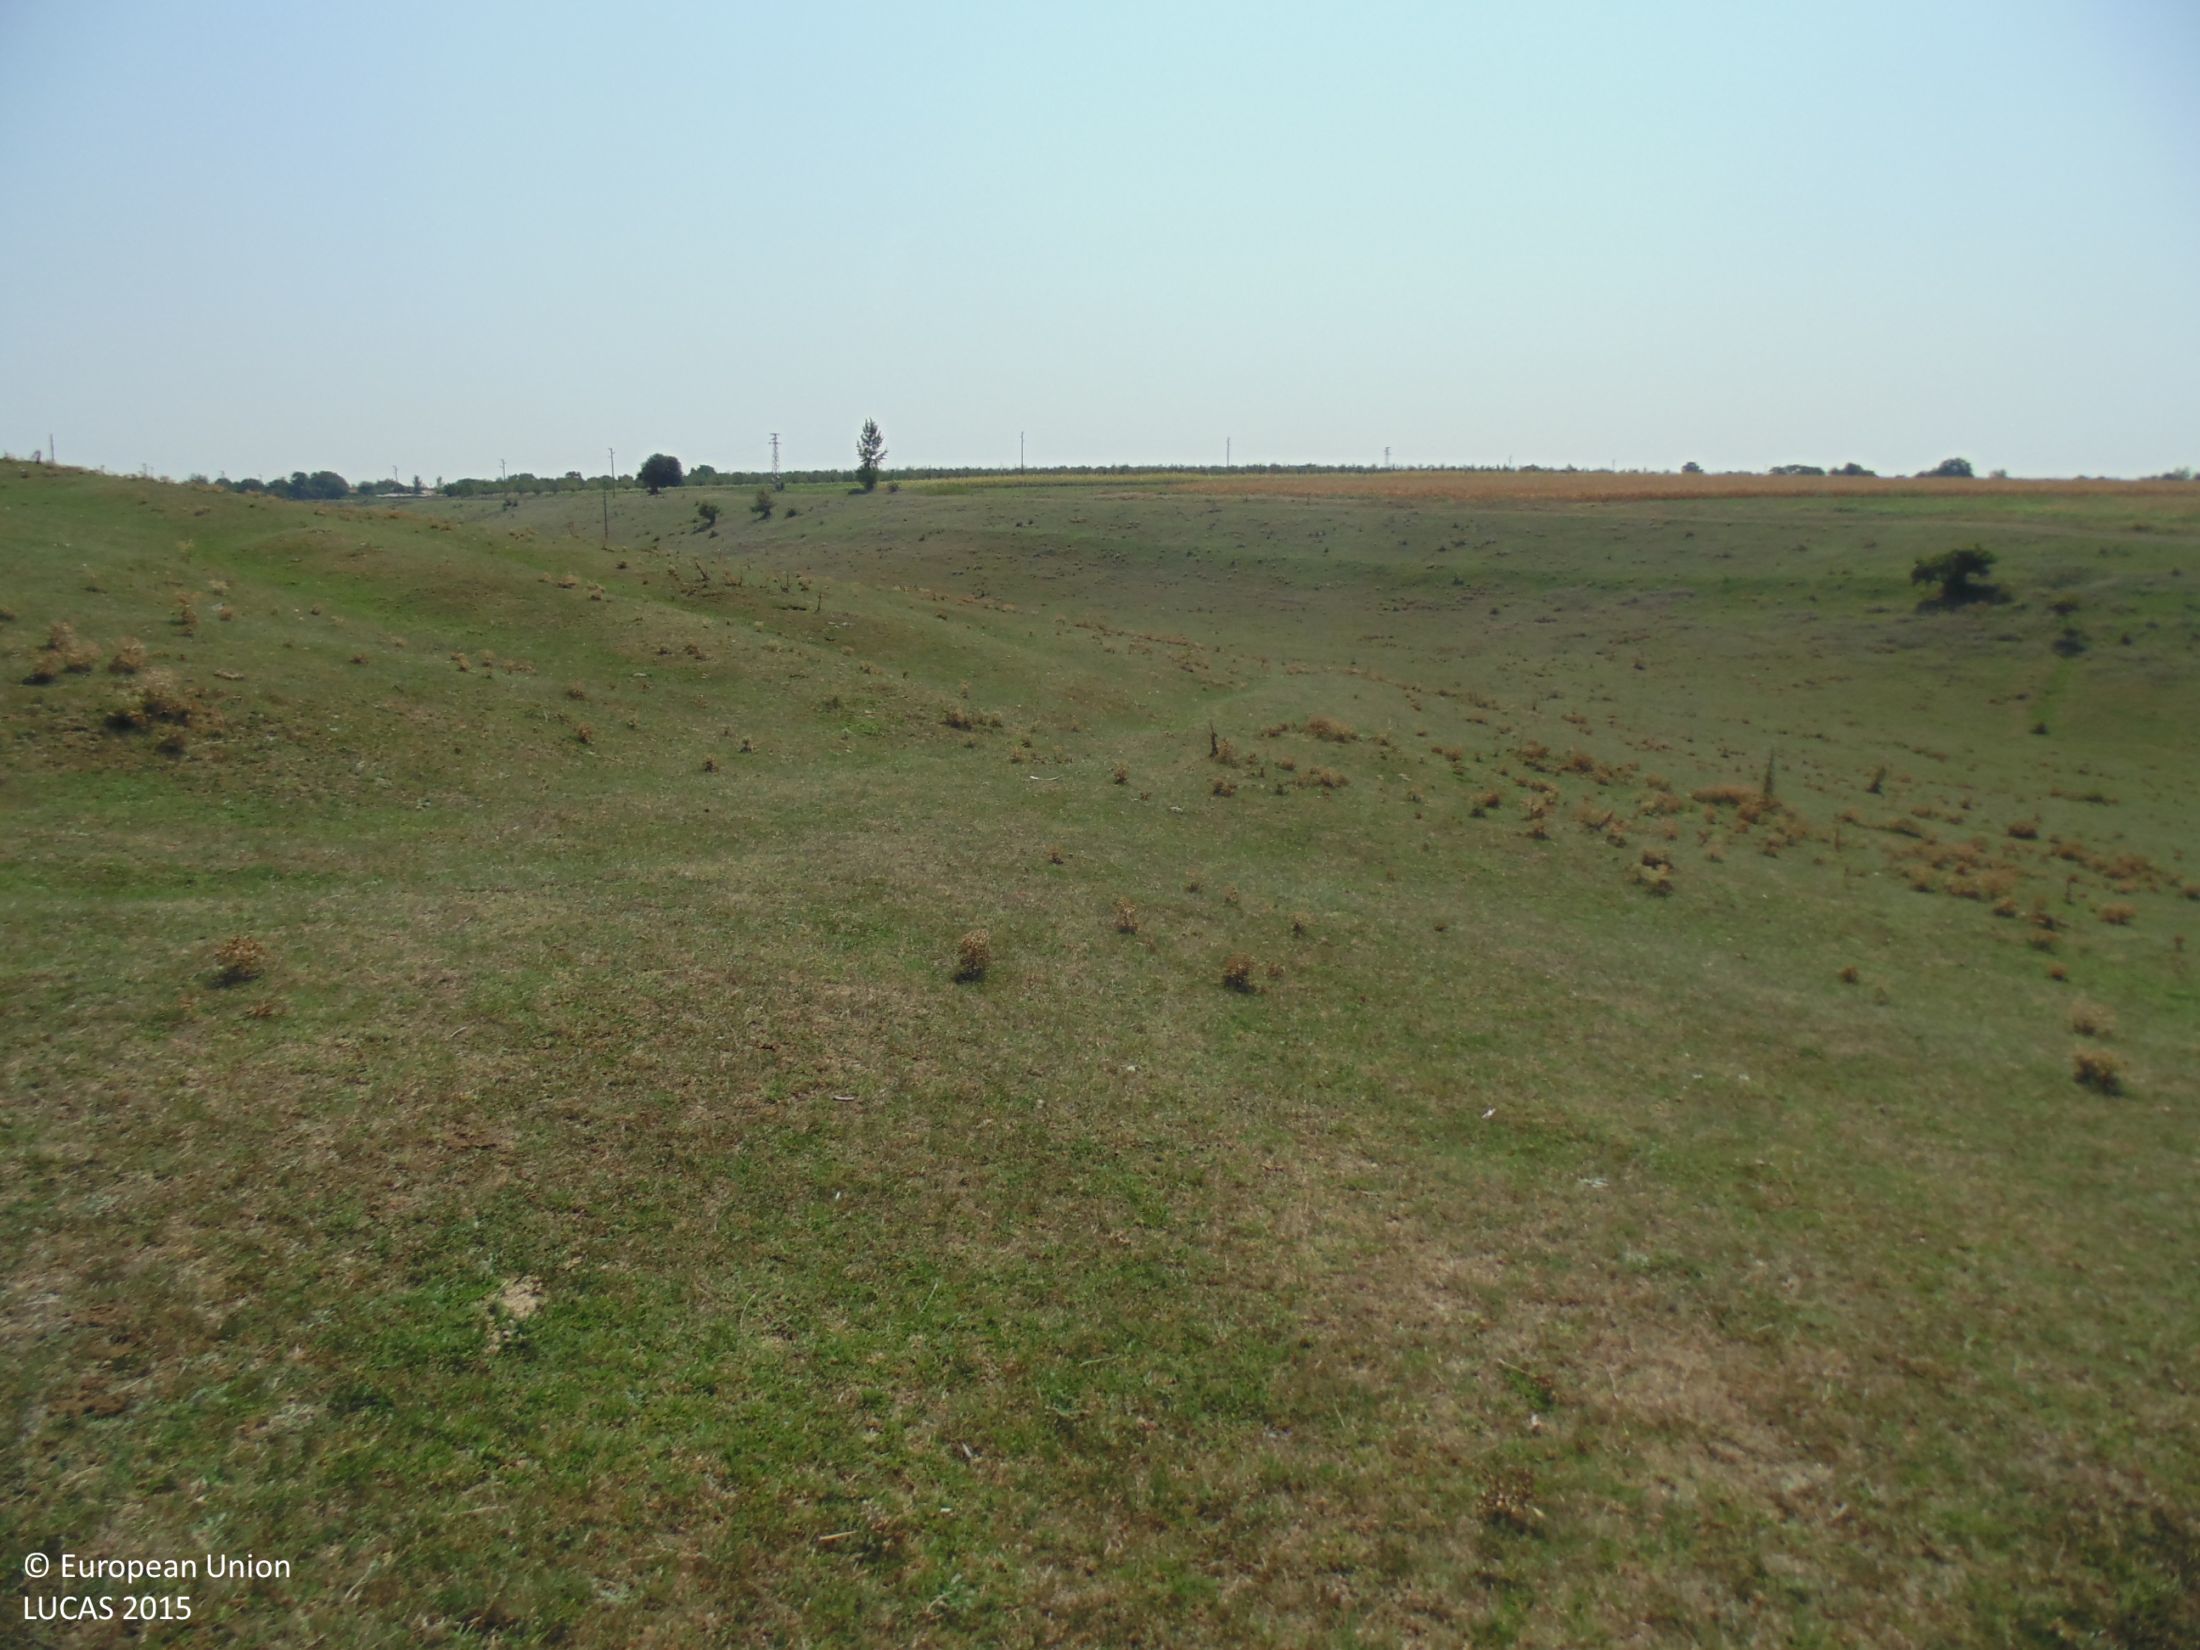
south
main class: Grassland
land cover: Grassland without tree/shrub cover
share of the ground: > 75 %
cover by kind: herbaceous plants 100 %
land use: Agriculture (excluding fallow land and kitchen gardens)
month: September
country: BG
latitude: 43.7928
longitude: 26.9338
